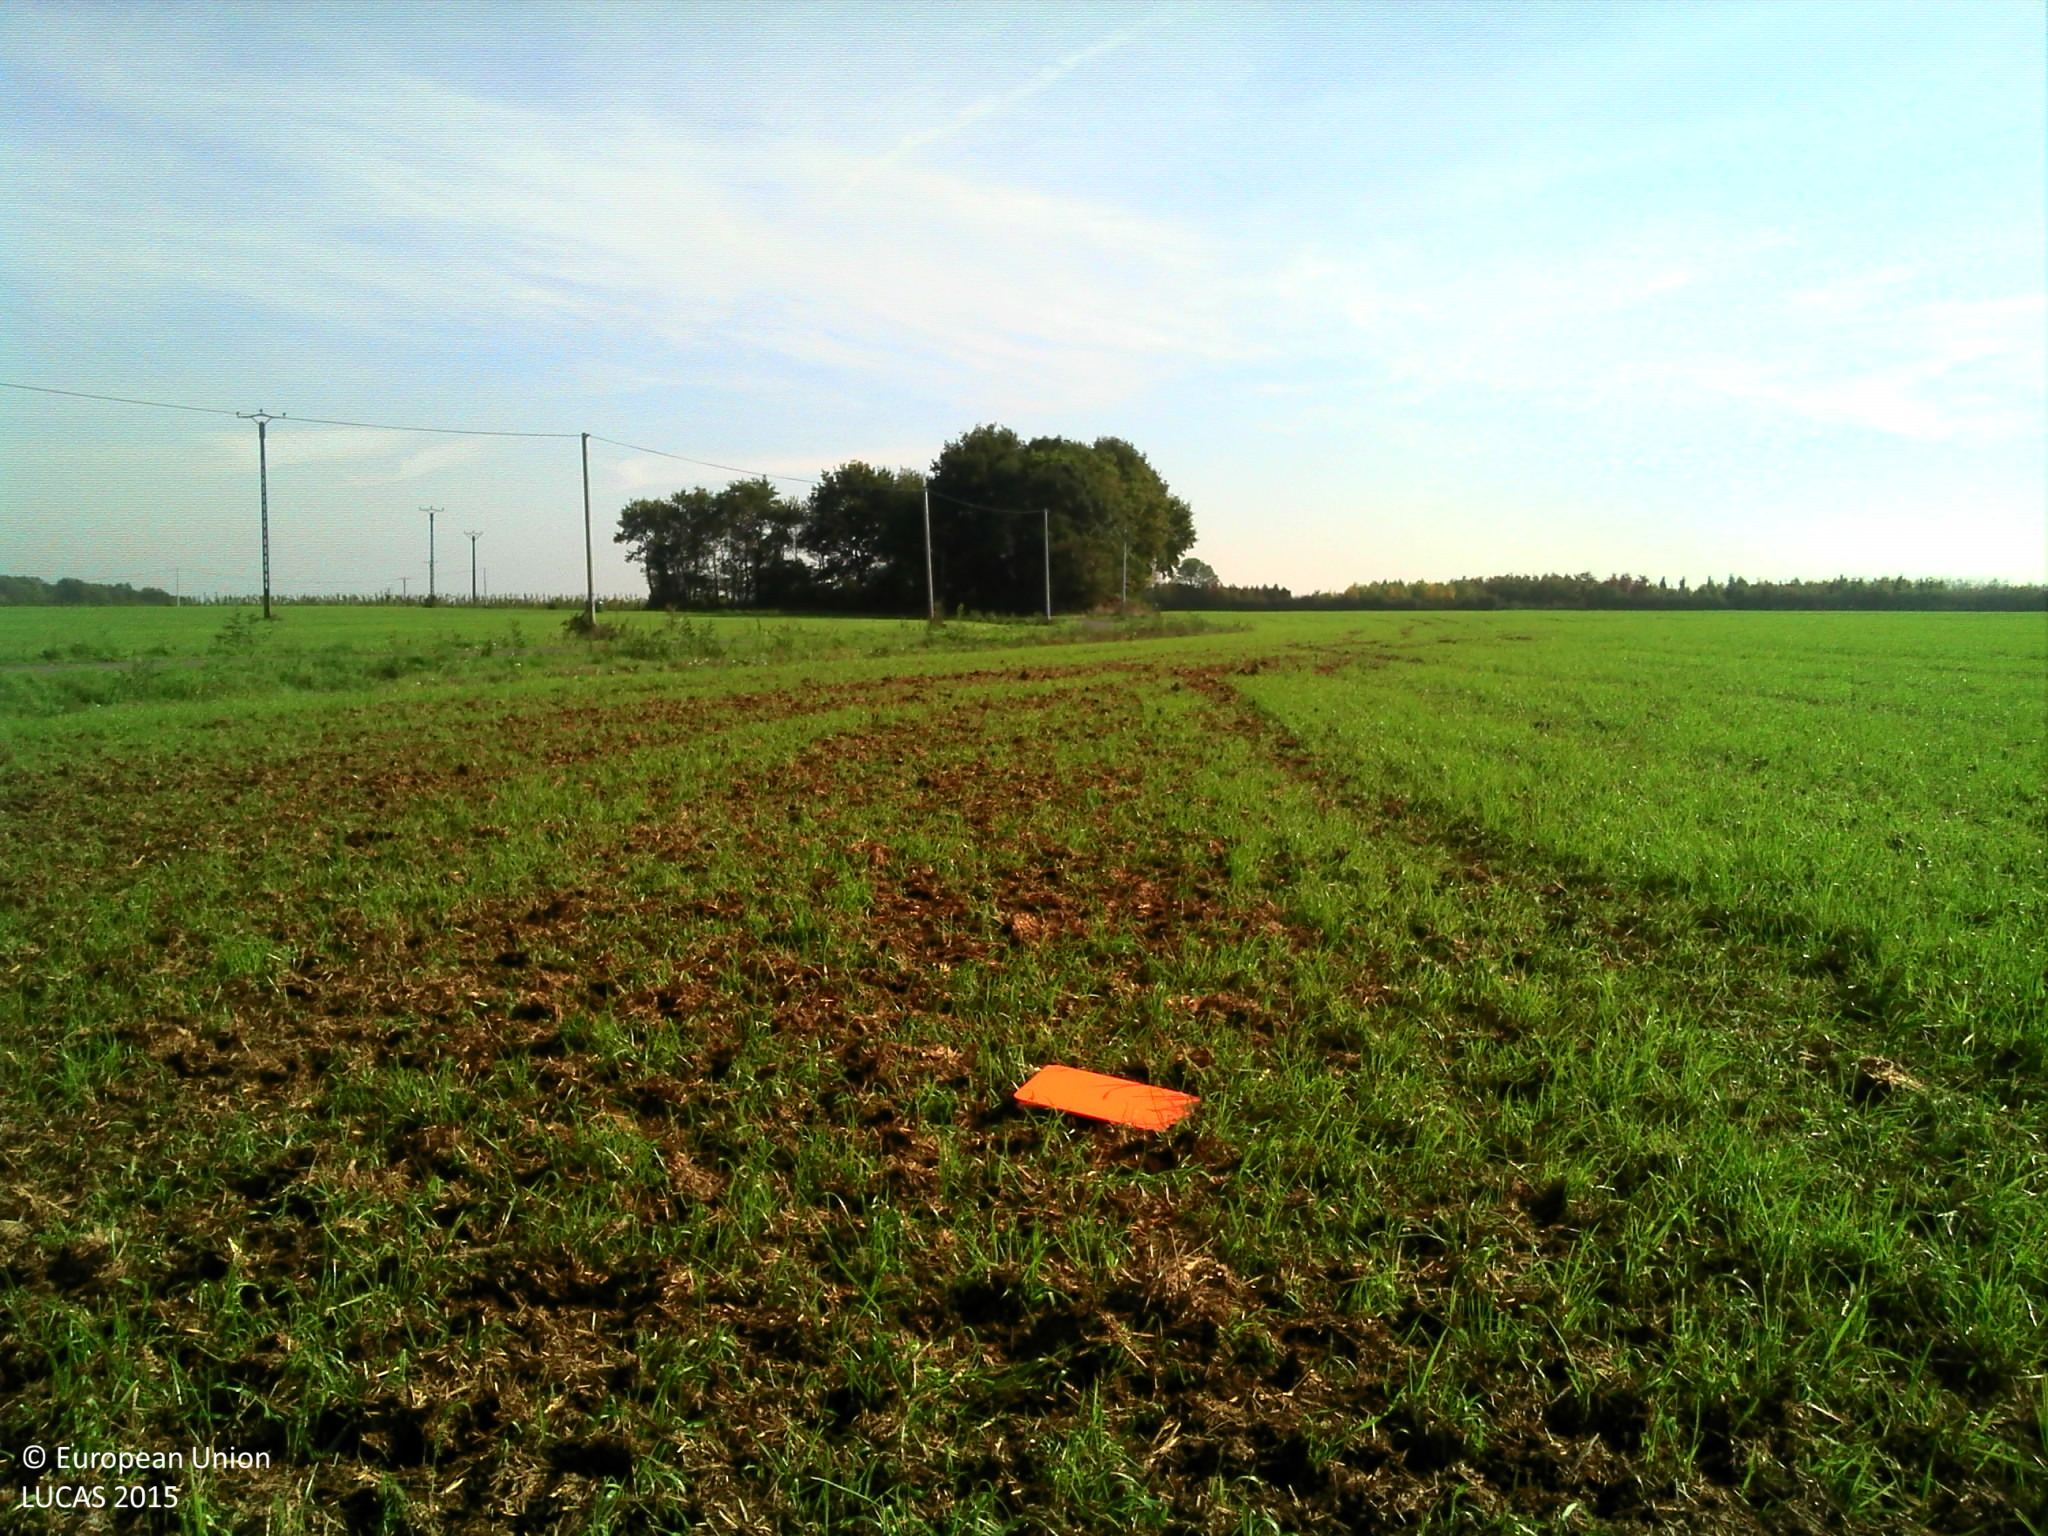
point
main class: Cropland
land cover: Temporary grasslands
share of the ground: > 75 %
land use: Agriculture (excluding fallow land and kitchen gardens)
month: October
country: FR
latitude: 47.1862
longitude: -0.9485
